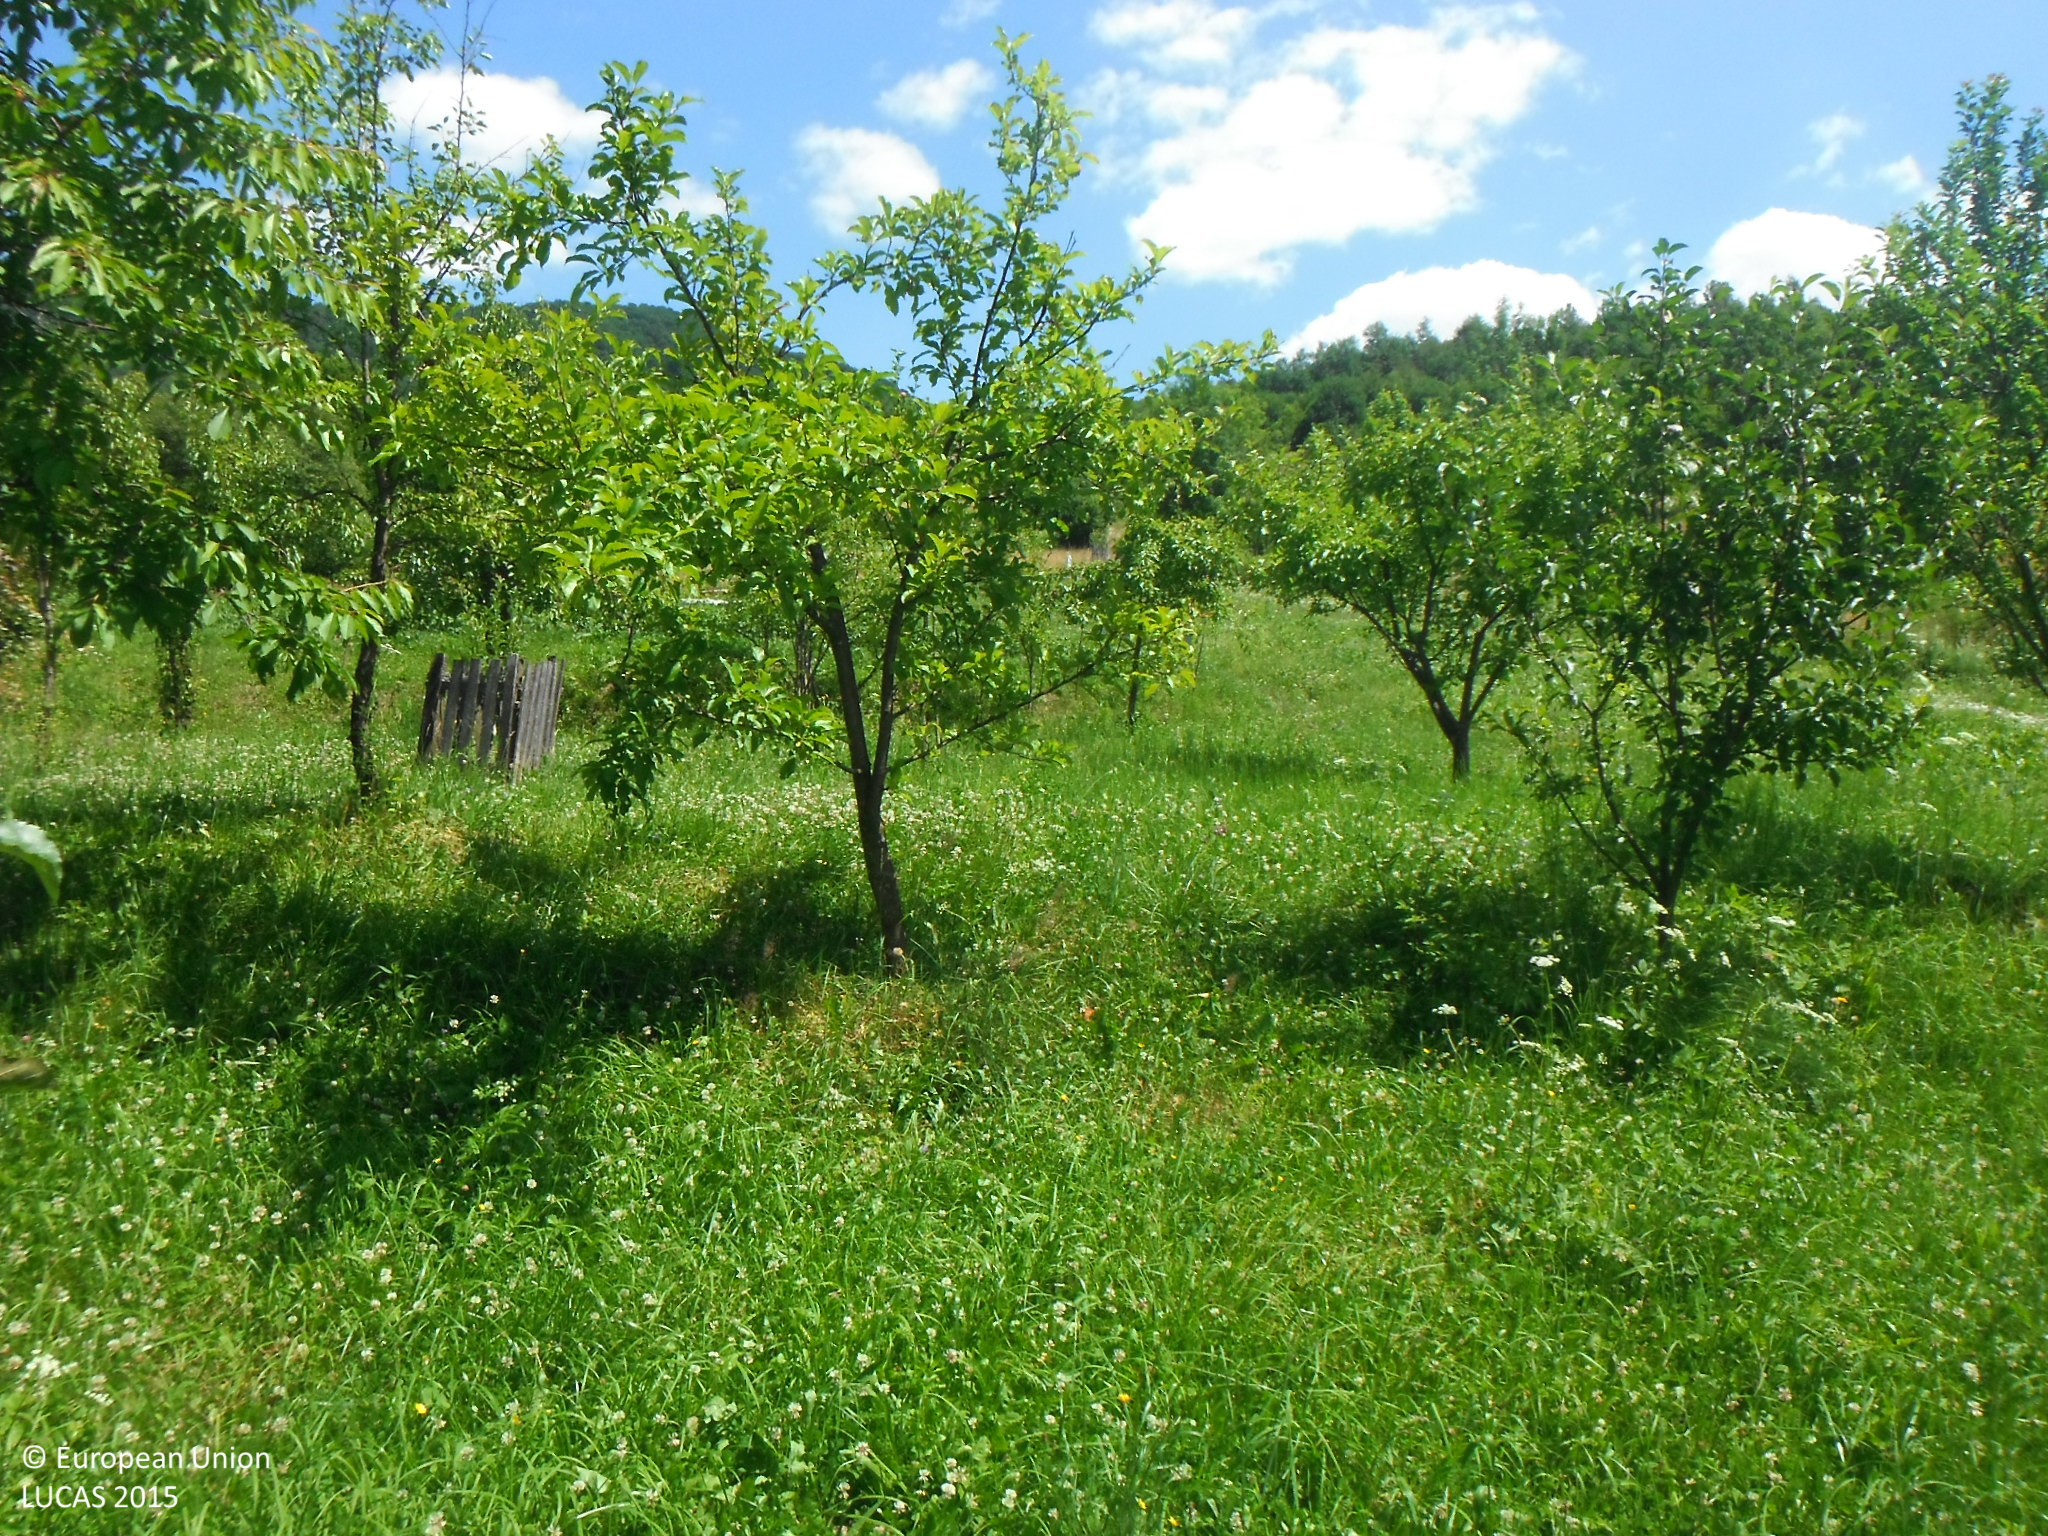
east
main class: Cropland
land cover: Apple fruit
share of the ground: 50 - 75 %
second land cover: Grassland without tree/shrub cover
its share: > 75 %
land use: Kitchen garden
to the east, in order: Apple fruit; Grassland without tree/shrub cover; Potatoes; Grass margins; Potatoes; Grass margins; Potatoes; Grass margins; Fences; Grass margins; Grassland without tree/shrub cover; Broadleaved woodland
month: July
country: SK
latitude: 49.0296
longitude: 22.4122
